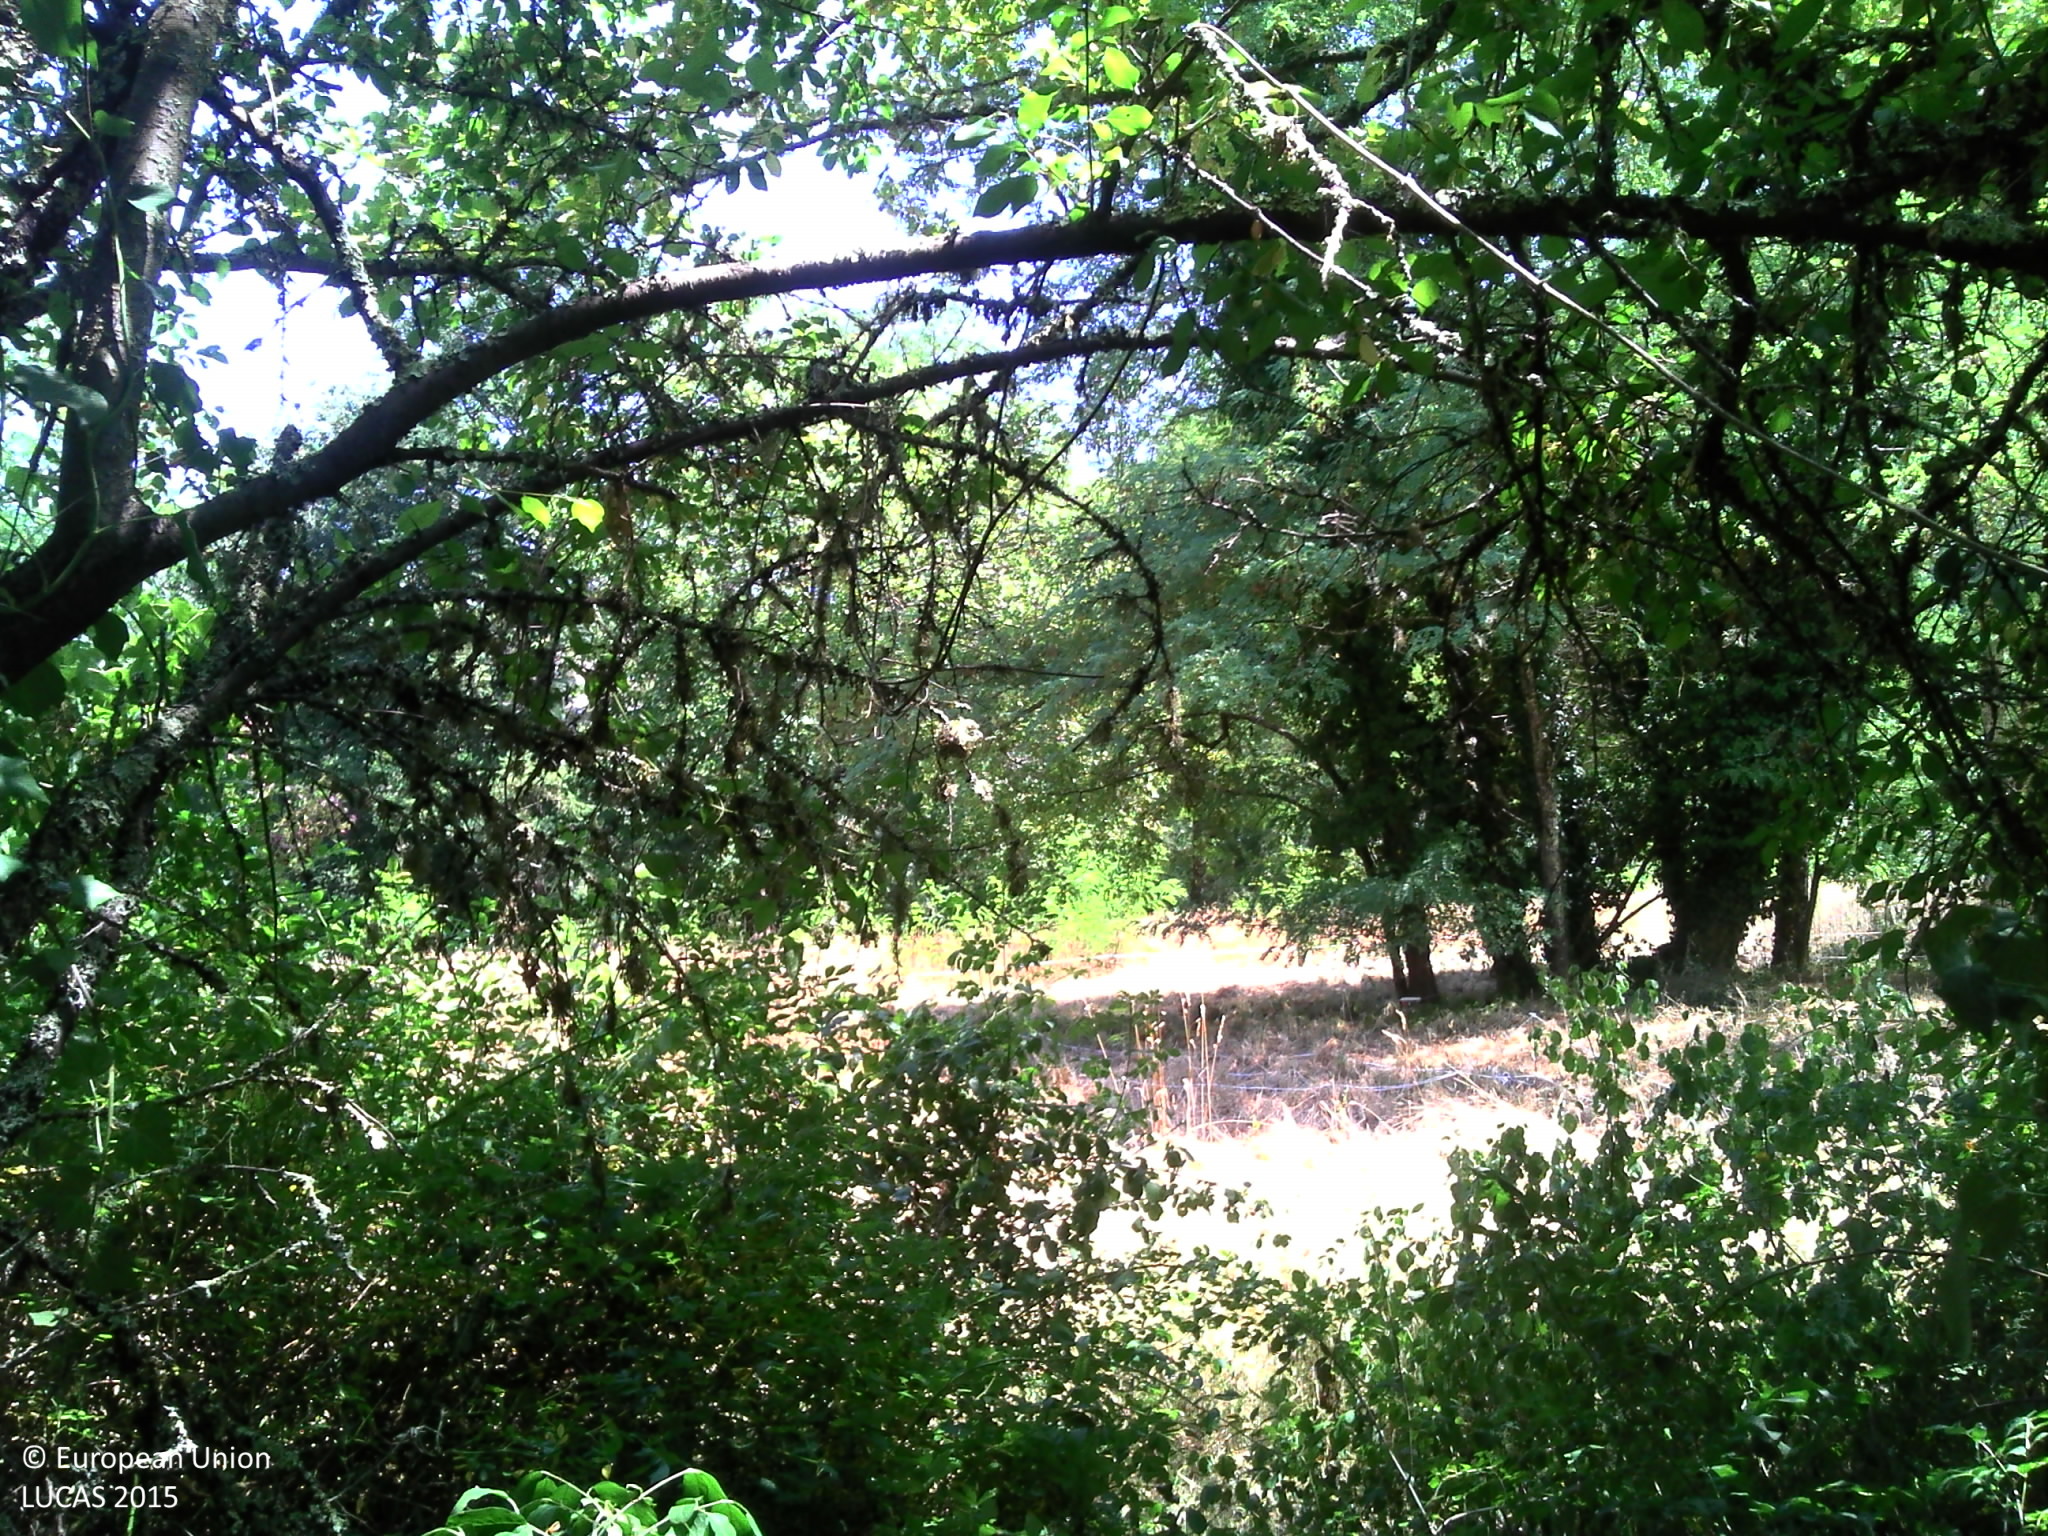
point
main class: Grassland
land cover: Grassland with sparse tree/shrub cover
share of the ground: > 75 %
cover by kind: herbaceous plants 95 %, broadleaved forest trees 5 %
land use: Agriculture (excluding fallow land and kitchen gardens)
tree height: > 5 m
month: July
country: FR
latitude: 44.4477
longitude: 4.3144
